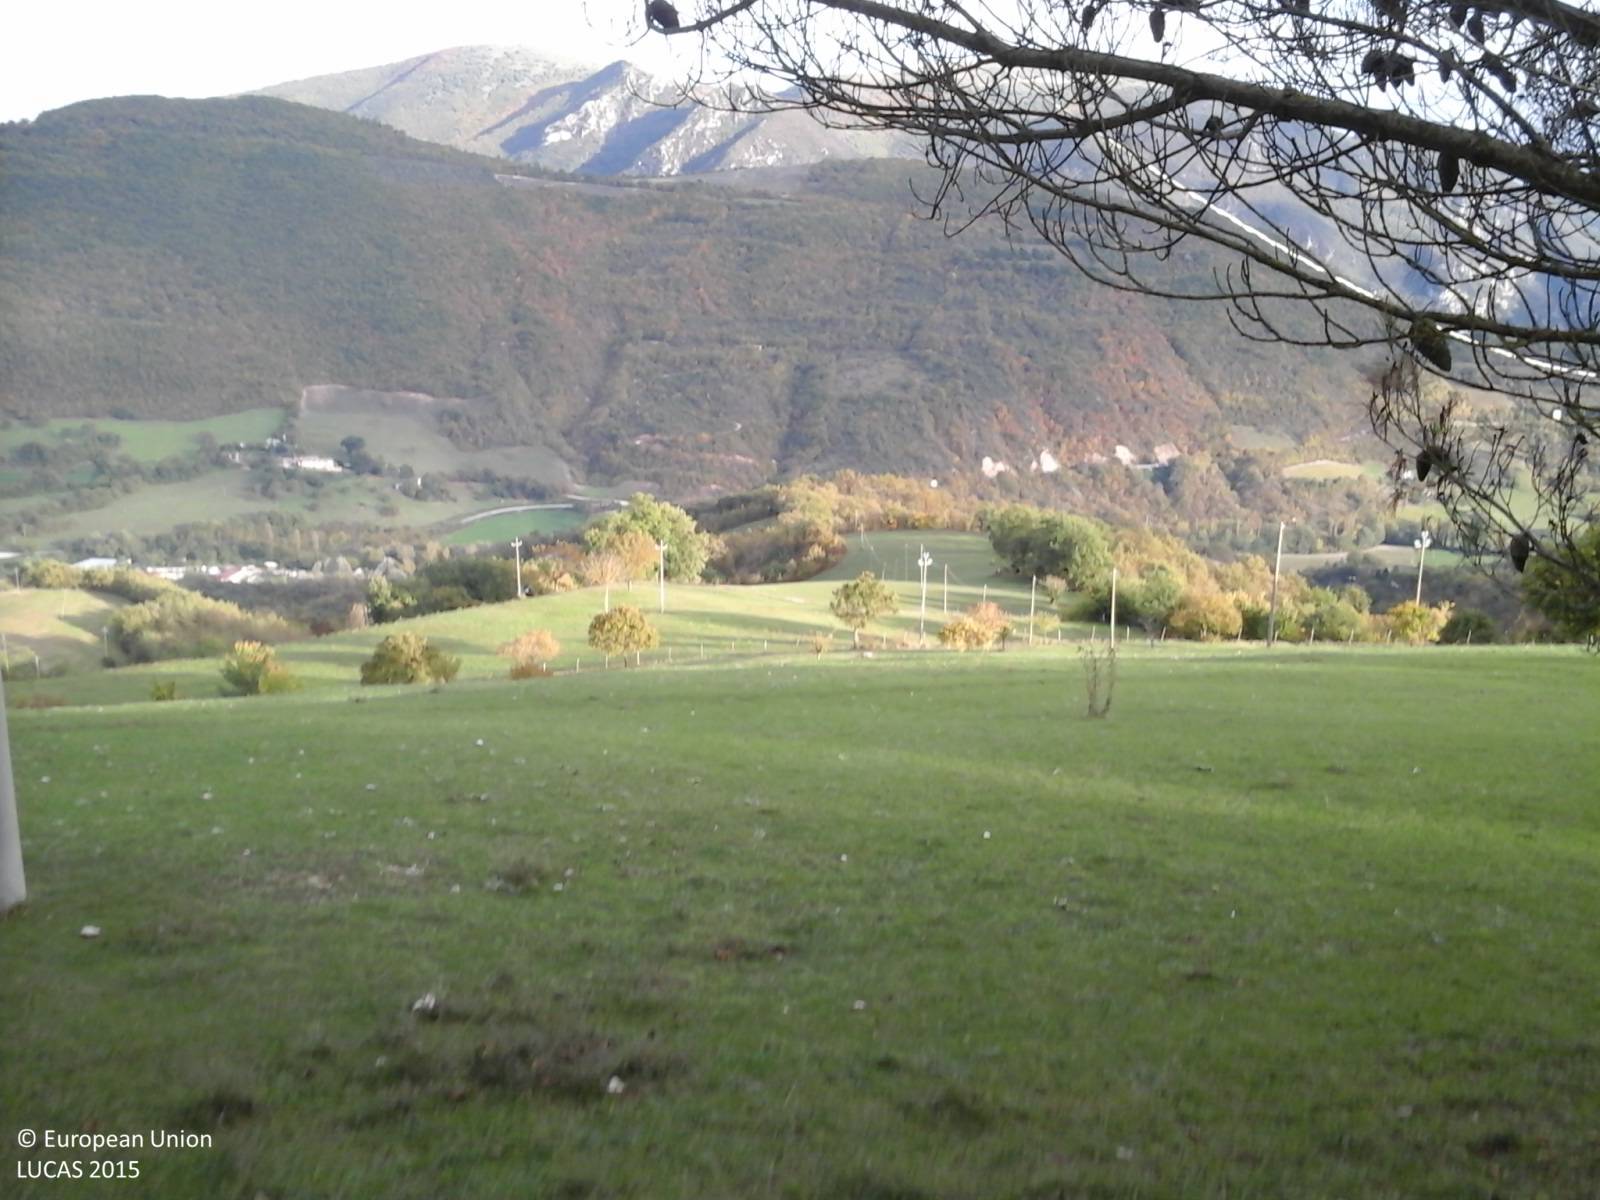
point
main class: Grassland
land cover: Grassland without tree/shrub cover
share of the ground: > 75 %
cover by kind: herbaceous plants 100 %
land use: Agriculture (excluding fallow land and kitchen gardens)
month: October
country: IT
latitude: 42.8470
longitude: 12.9158
